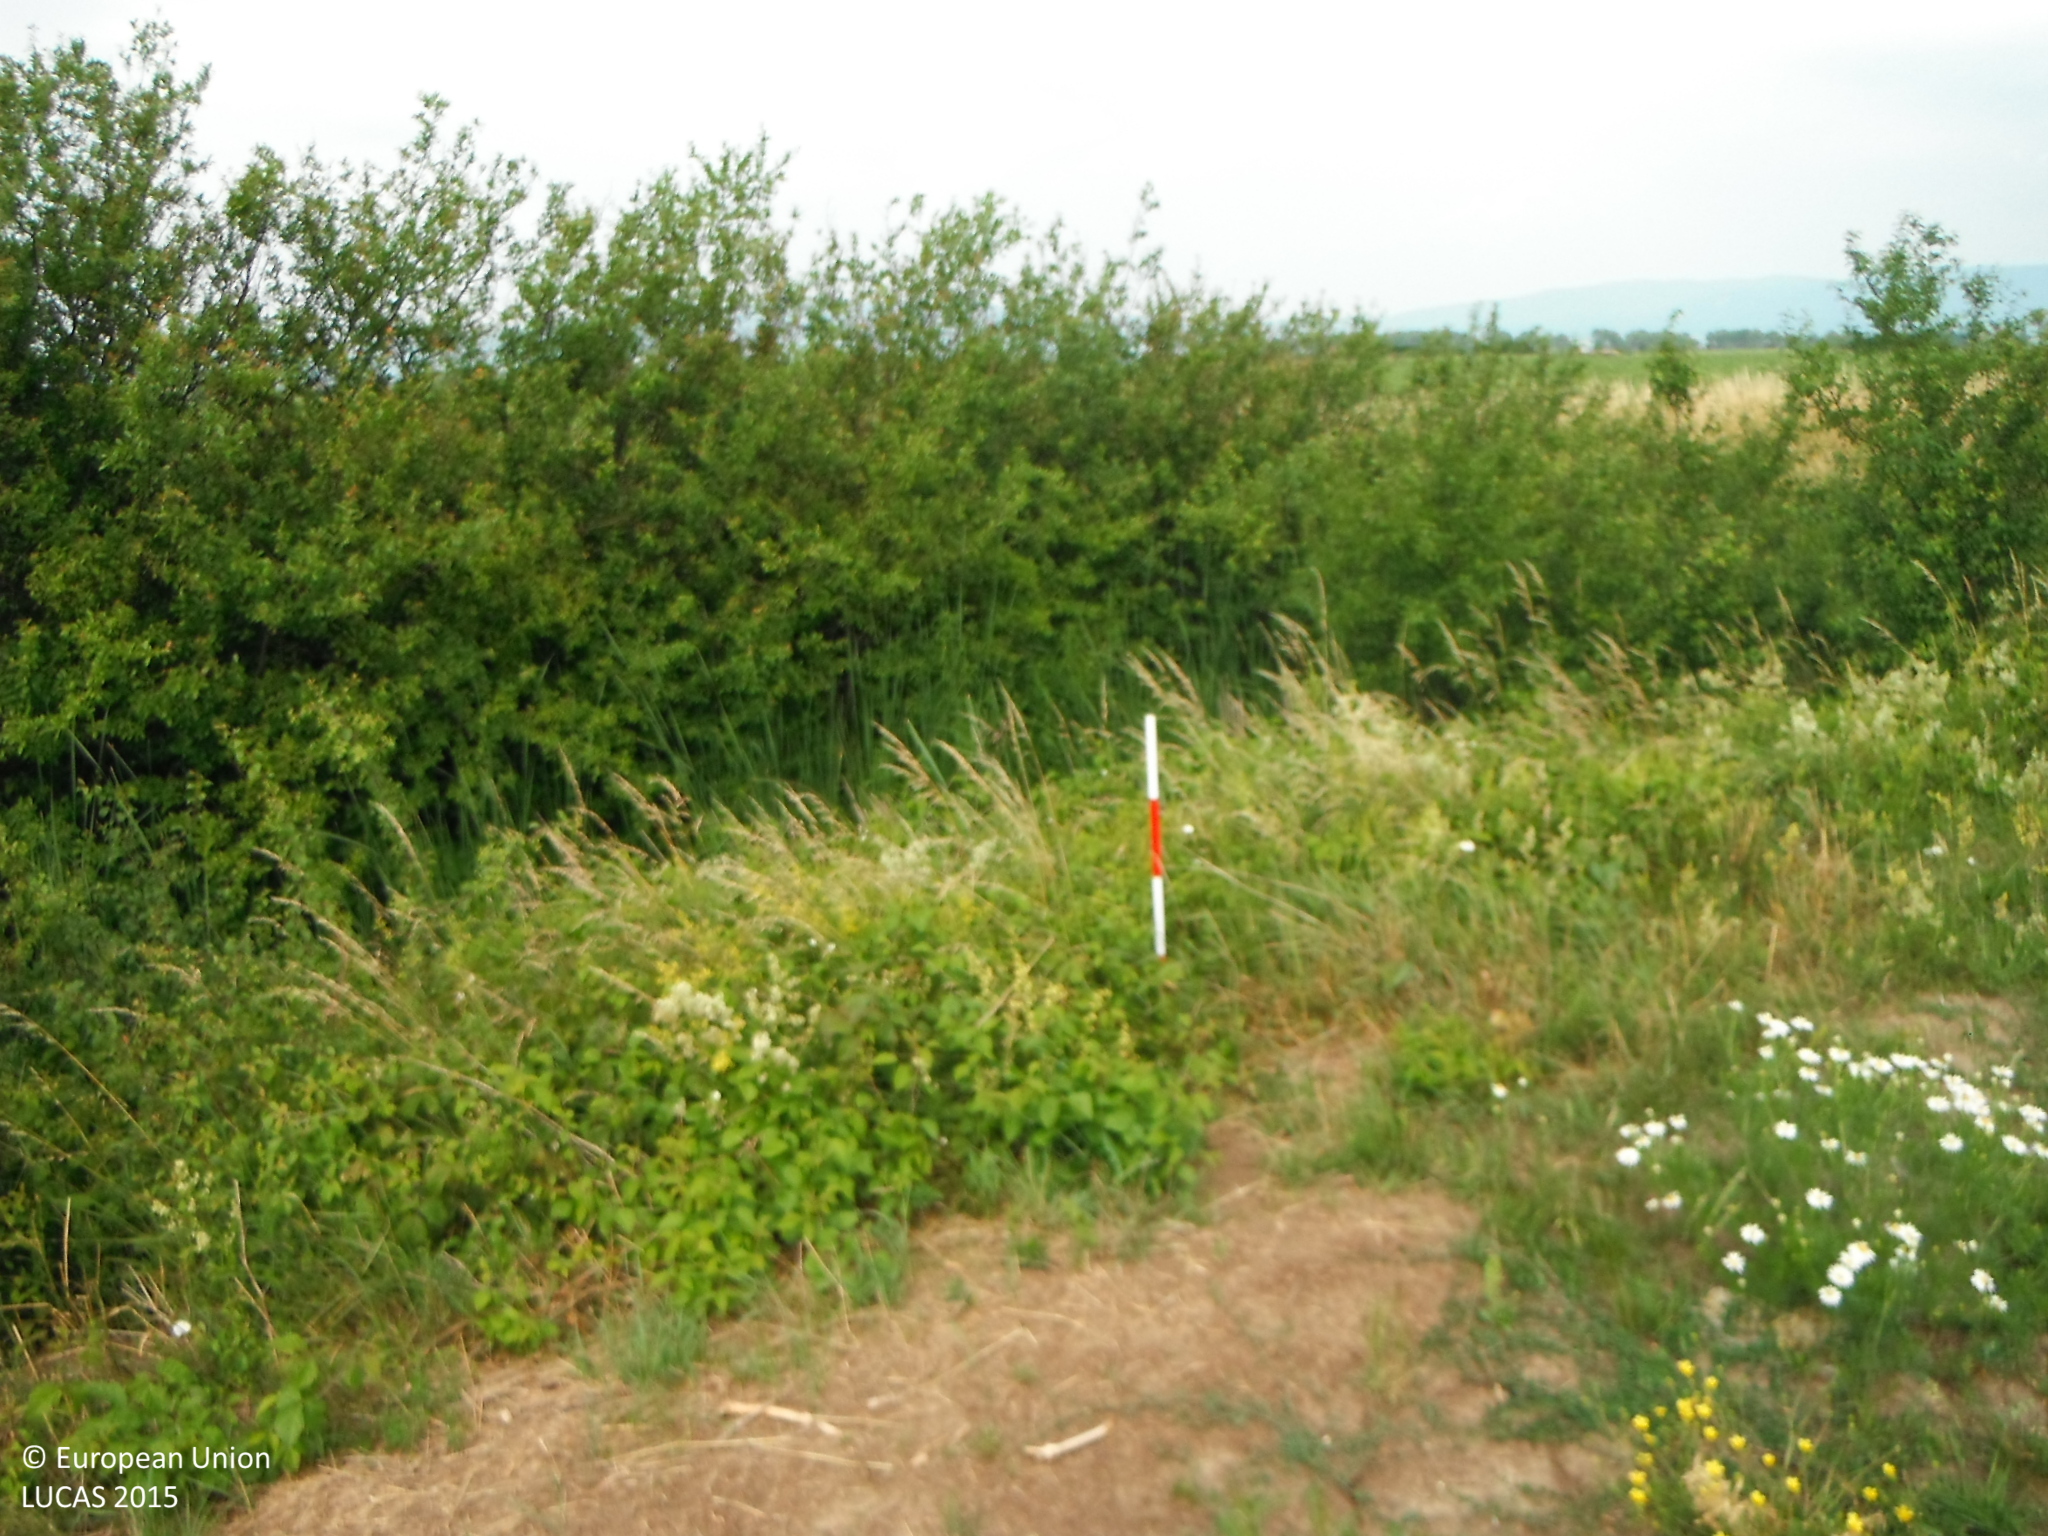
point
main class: Grassland
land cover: Spontaneously vegetated surfaces
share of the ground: > 75 %
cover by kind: herbaceous plants 100 %
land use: Semi-natural and natural areas not in use
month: June
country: SK
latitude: 48.6840
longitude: 21.7459
